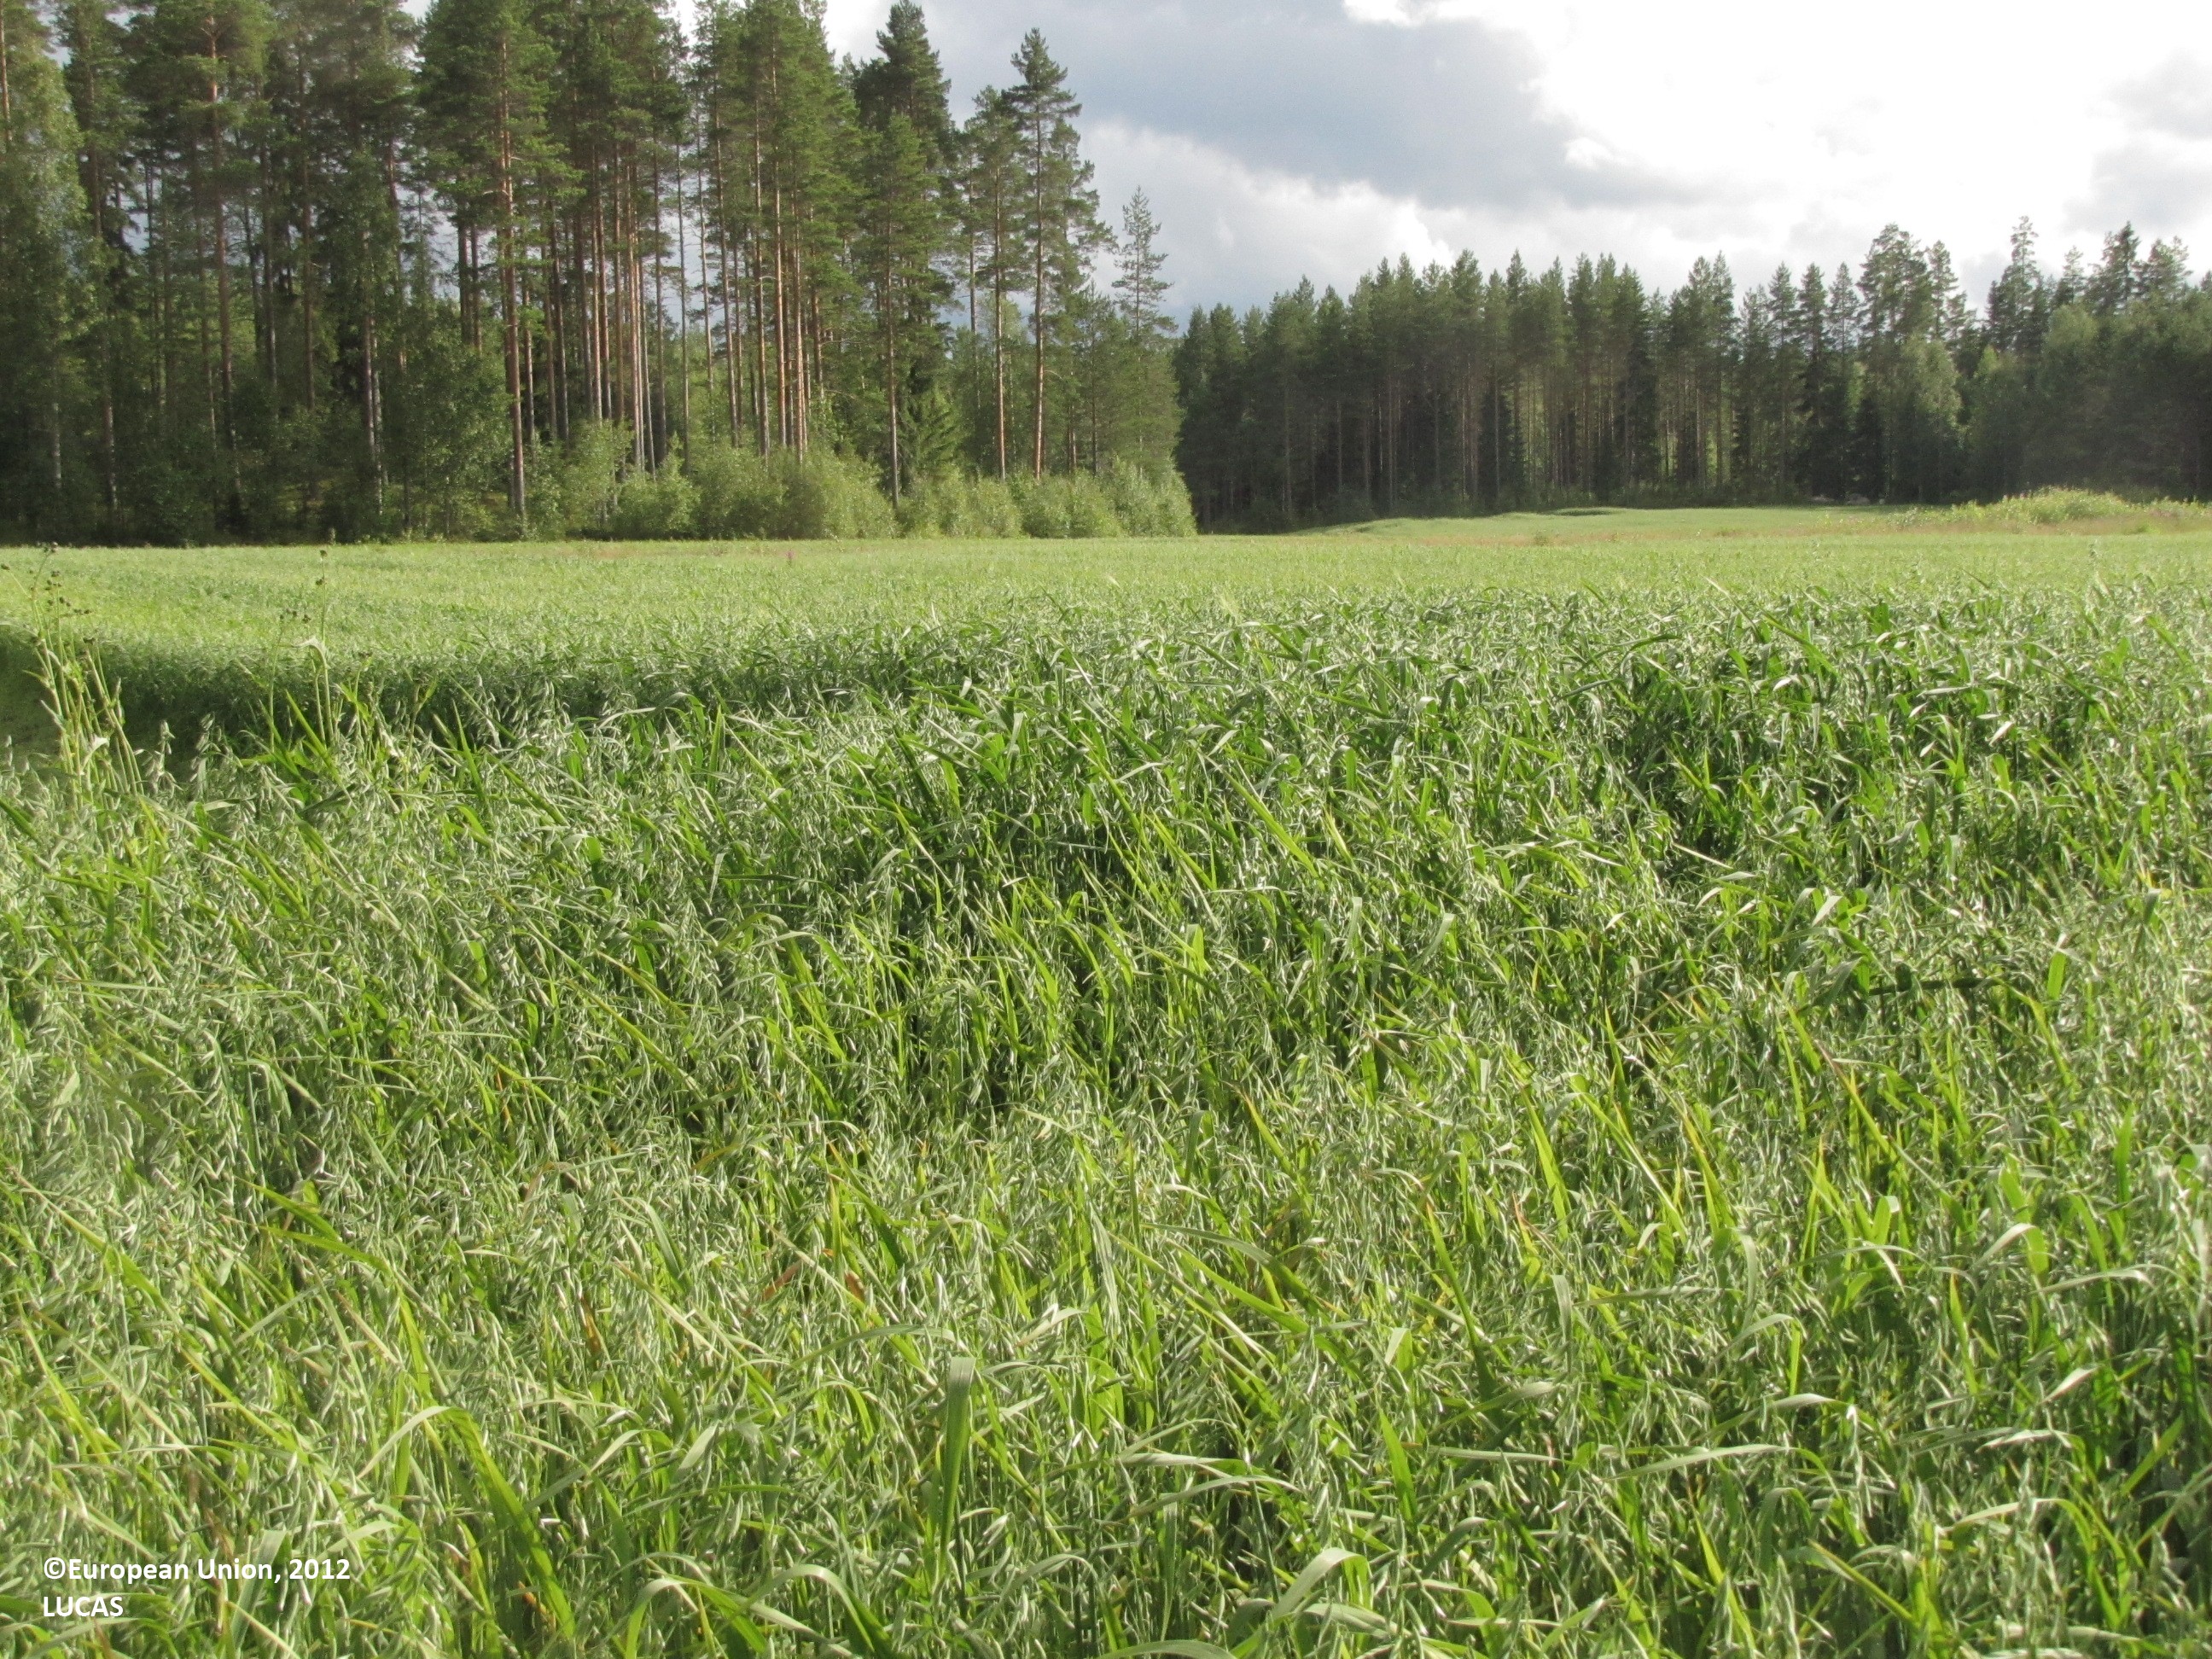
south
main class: Cropland
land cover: Oats
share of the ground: > 75 %
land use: Agriculture (excluding fallow land and kitchen gardens)
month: July
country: FI
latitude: 62.2742
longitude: 23.1105
